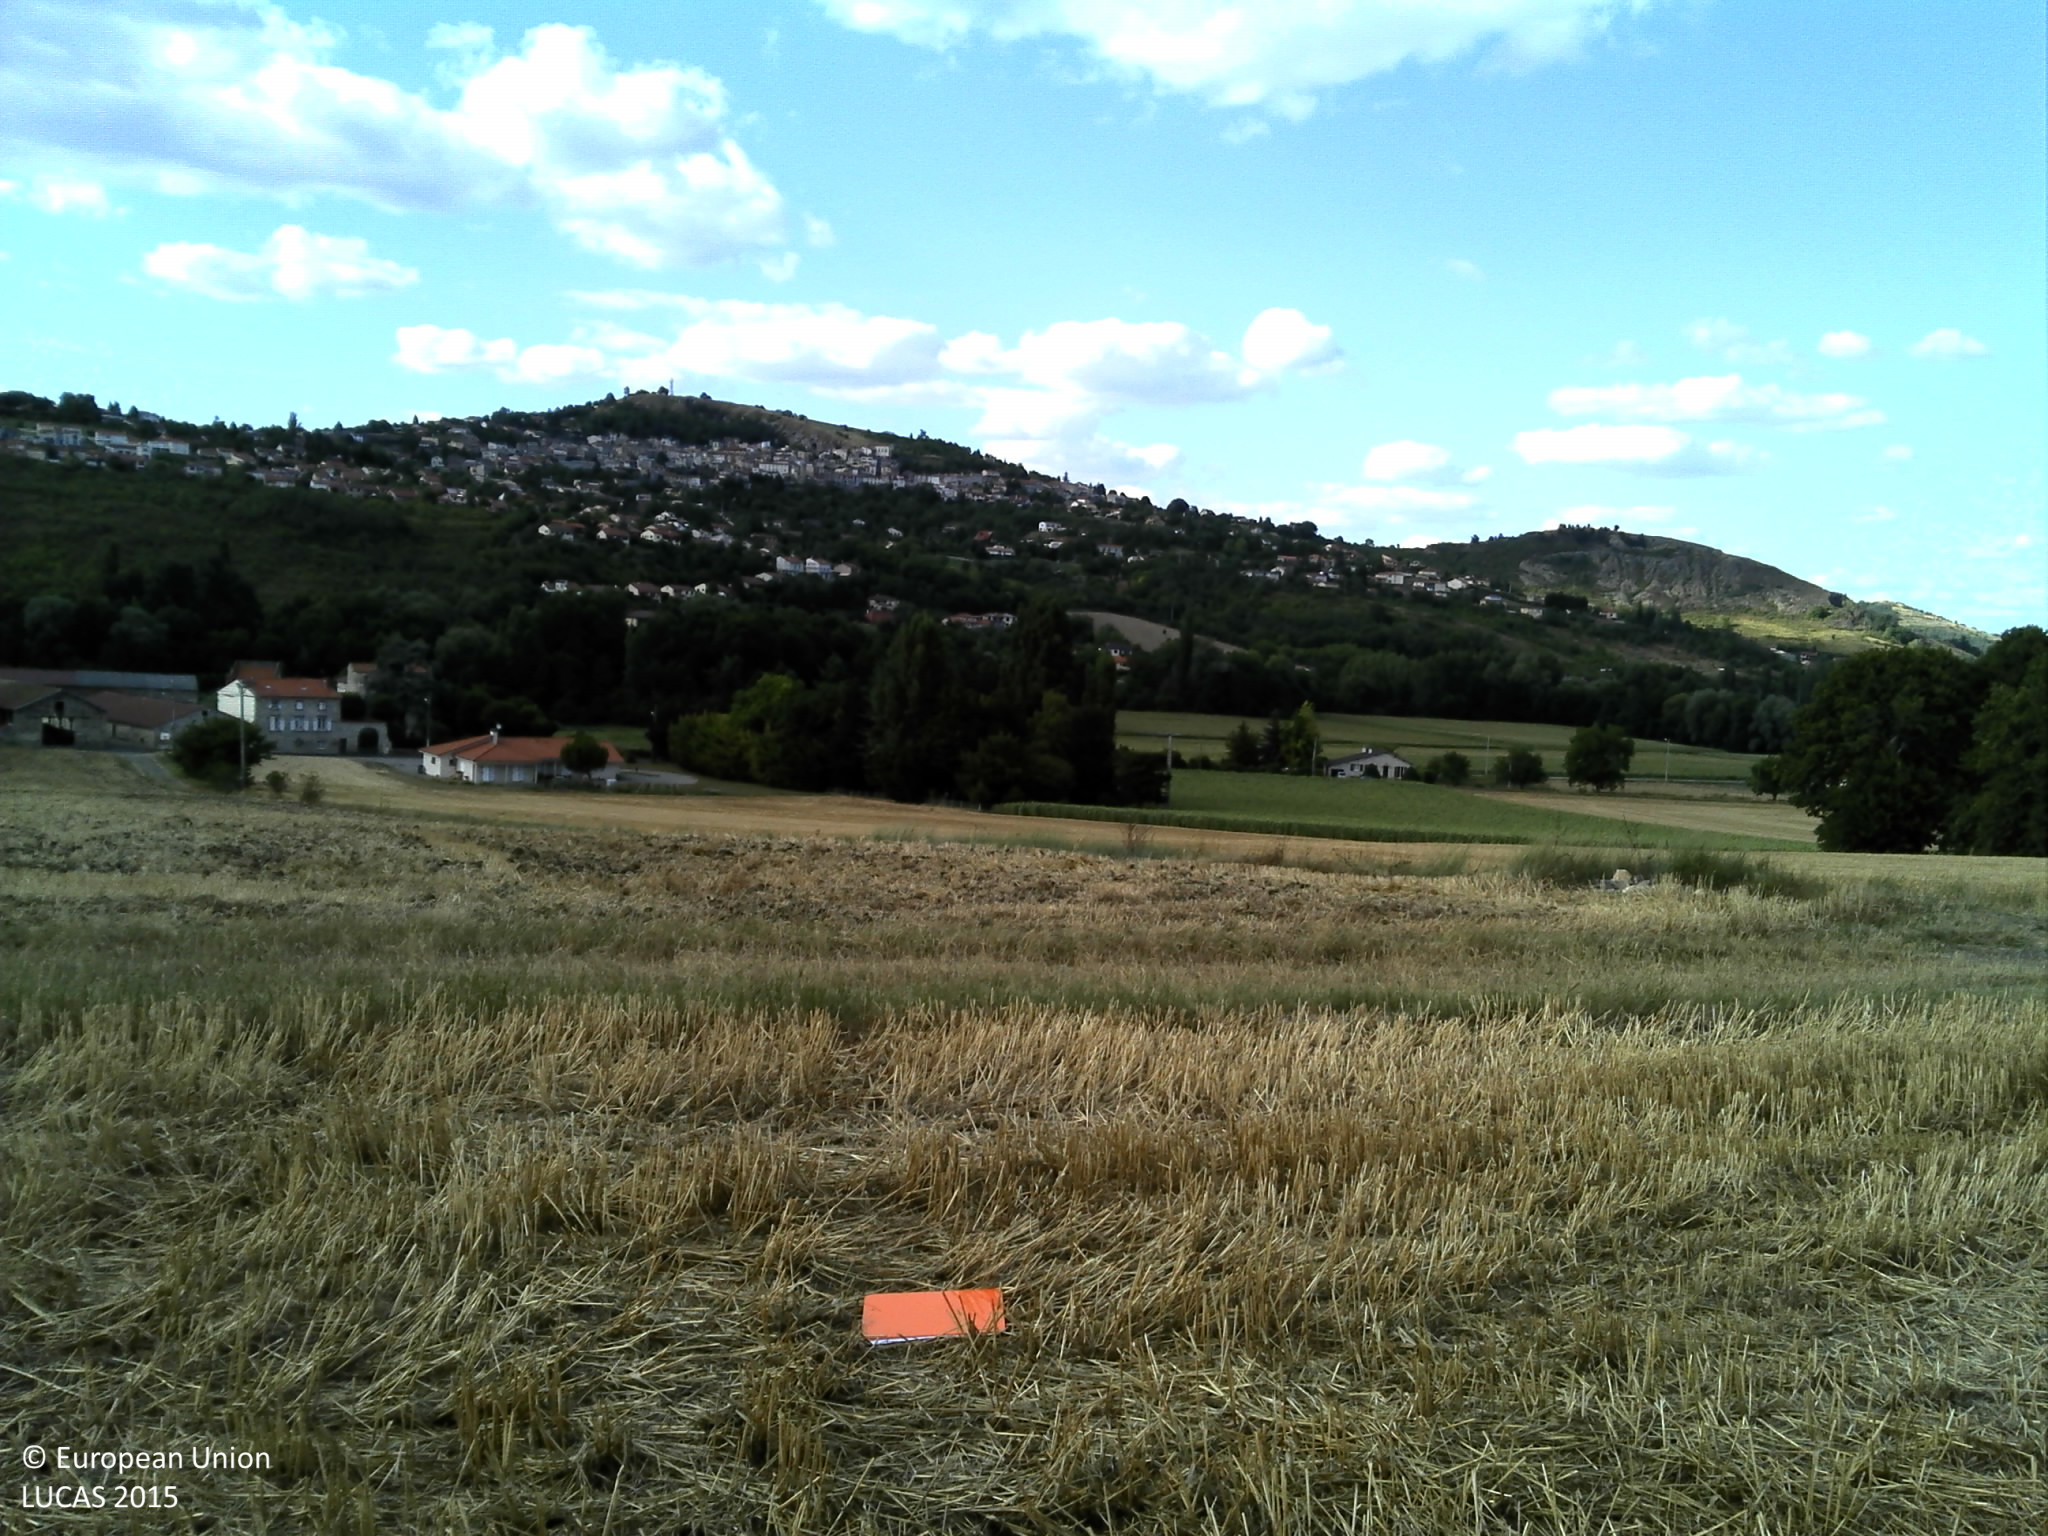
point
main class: Cropland
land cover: Common wheat
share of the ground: > 75 %
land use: Agriculture (excluding fallow land and kitchen gardens)
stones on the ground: 25 - 50 %
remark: Harvested field
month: July
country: FR
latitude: 45.6621
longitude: 3.1595
